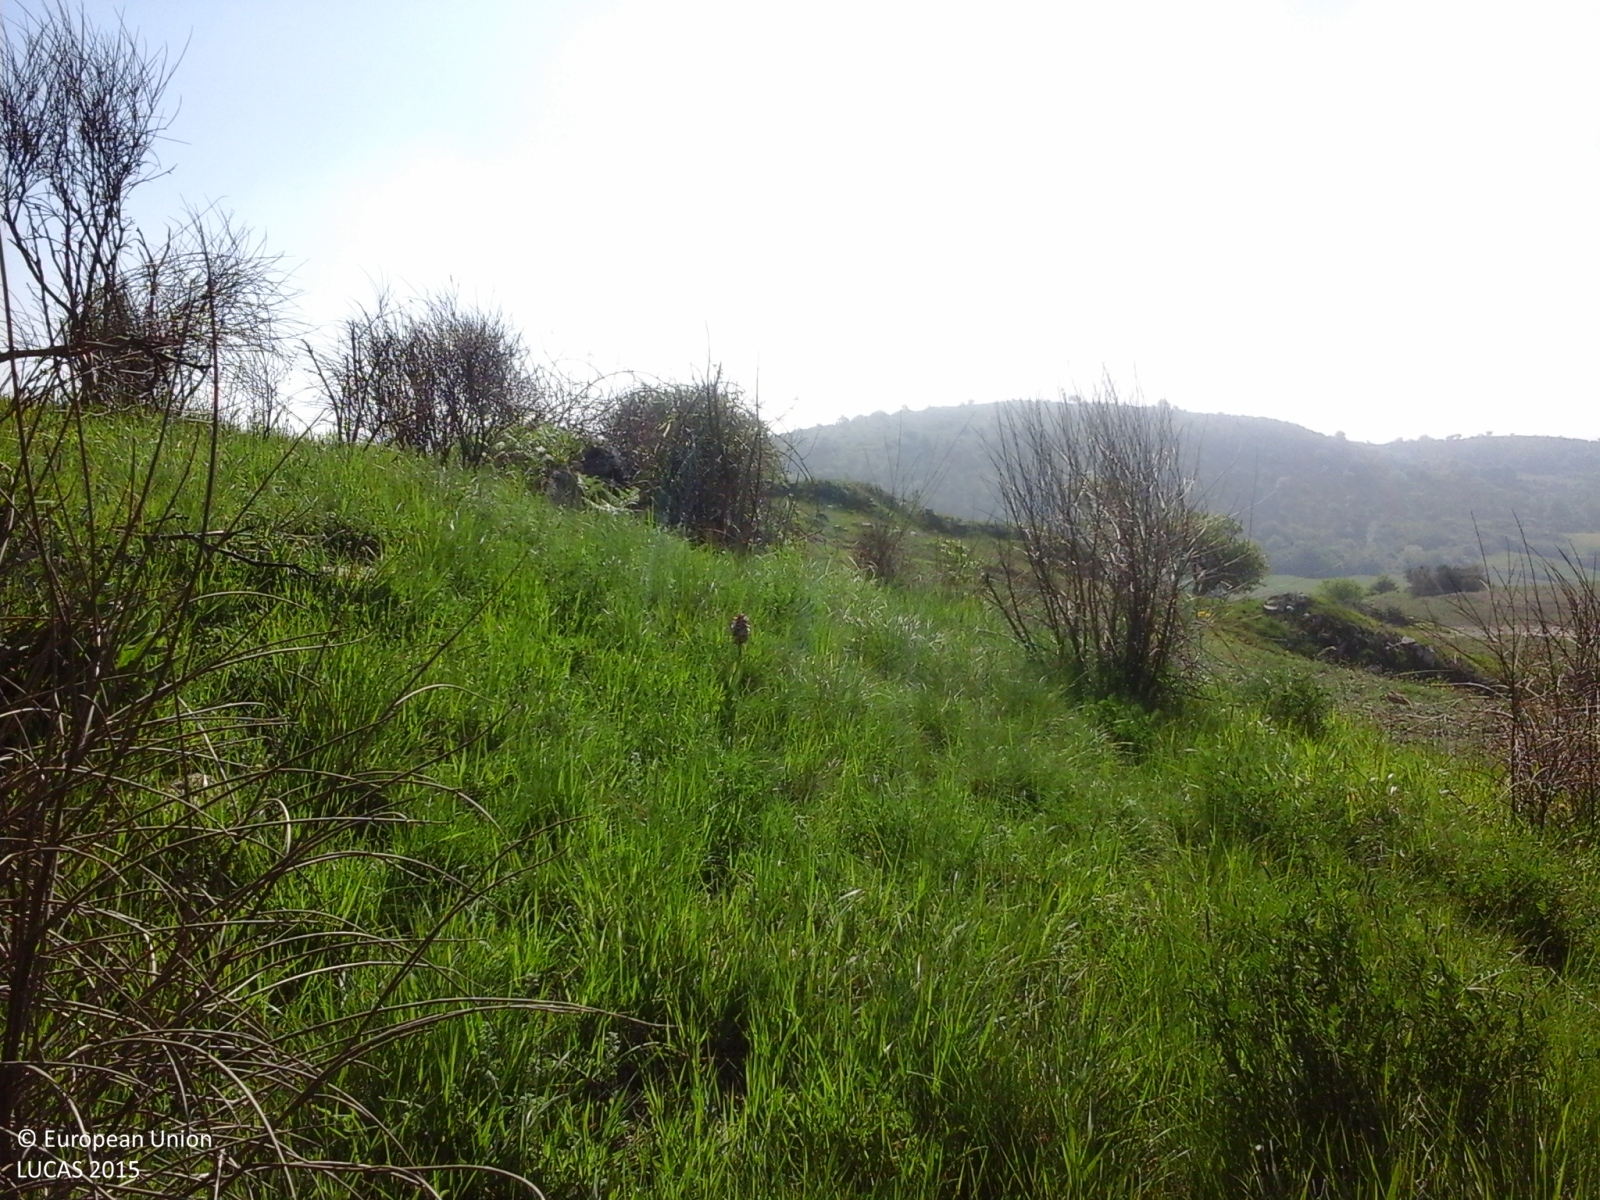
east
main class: Woodland
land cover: Broadleaved woodland
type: thermophilous deciduous forest
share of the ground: 25 - 50 %
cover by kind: herbaceous plants 50 %, broadleaved forest trees 40 %, shrubs 10 %
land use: Agriculture (excluding fallow land and kitchen gardens)
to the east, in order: Broadleaved woodland; Other leguminous and mixtures for fodder; Single bushes/trees; Other leguminous and mixtures for fodder; Grassland with sparse tree/shrub cover; Abandoned hedges; Other leguminous and mixtures for fodder; Abandoned hedges; Tracks; Grass margins; Abandoned hedges; Rock outcrops; Other leguminous and mixtures for fodder
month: May
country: IT
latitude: 41.2803
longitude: 14.6510
